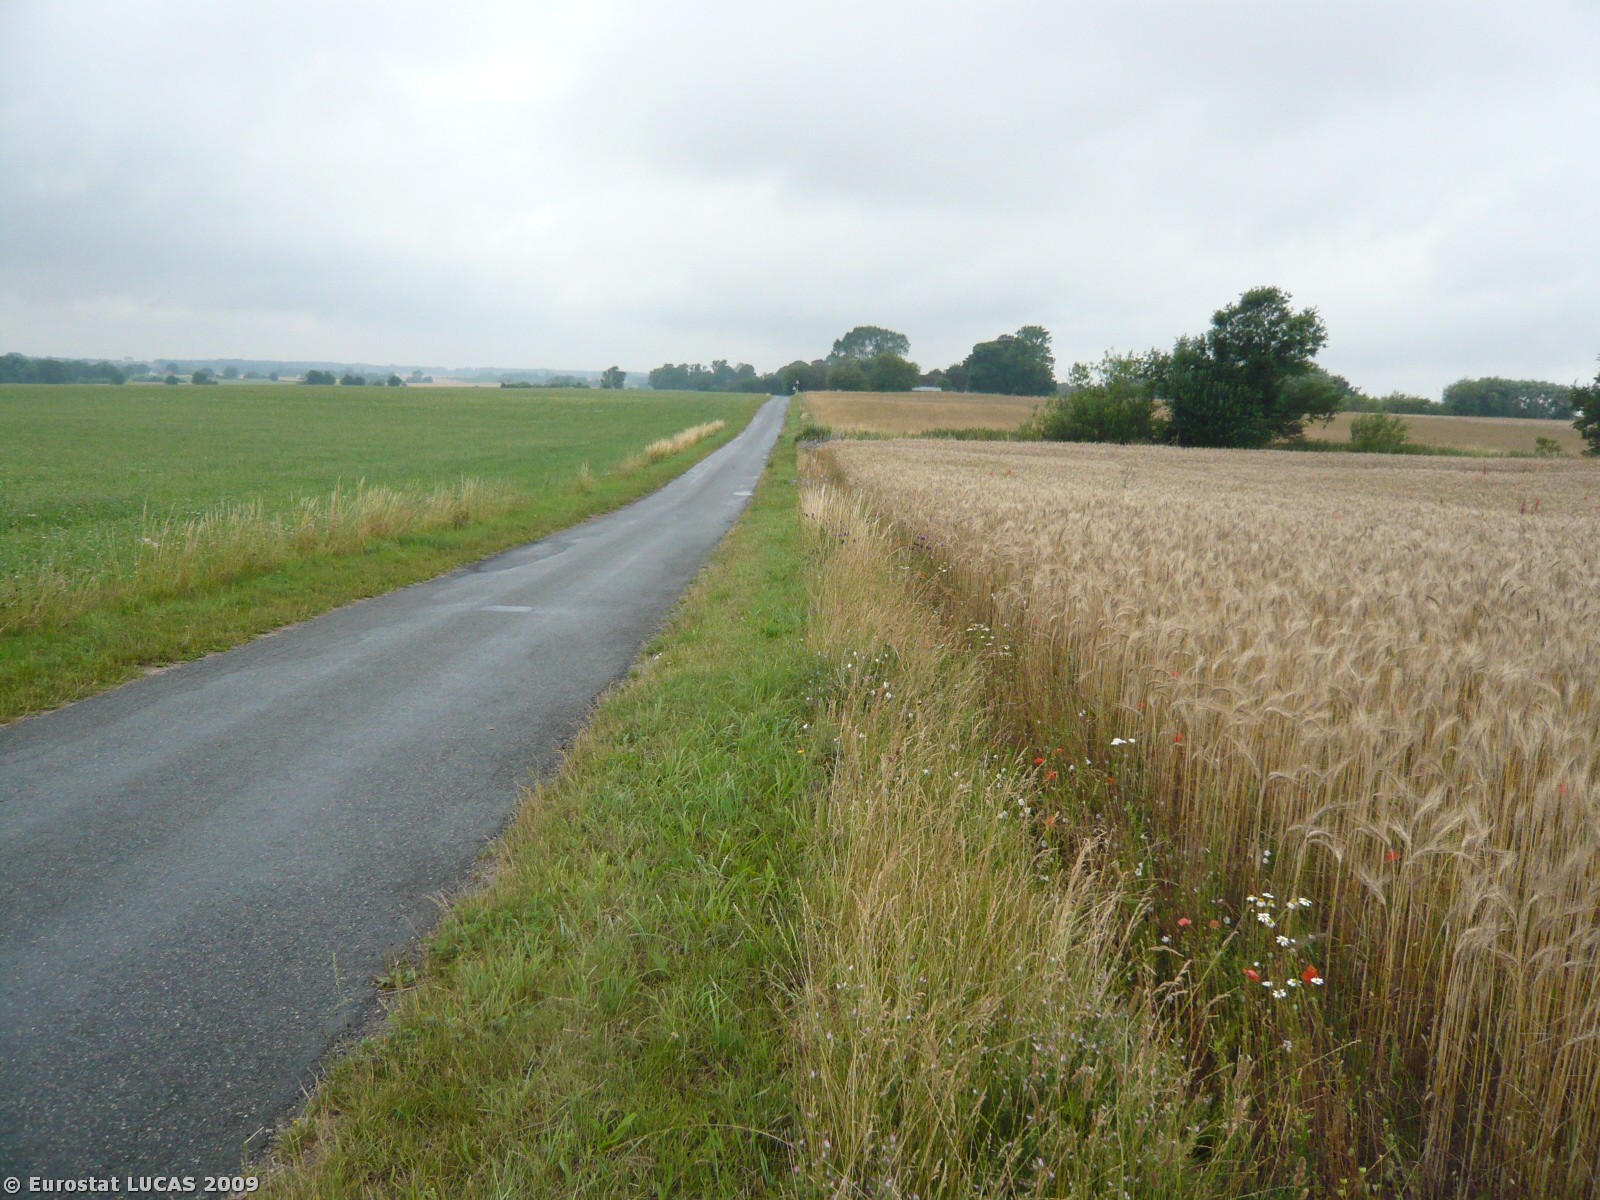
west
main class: Cropland
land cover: Durum wheat
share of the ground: > 75 %
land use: Agriculture (excluding fallow land and kitchen gardens)
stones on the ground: < 10 %
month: July
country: DK
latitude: 55.6699
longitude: 11.9221
